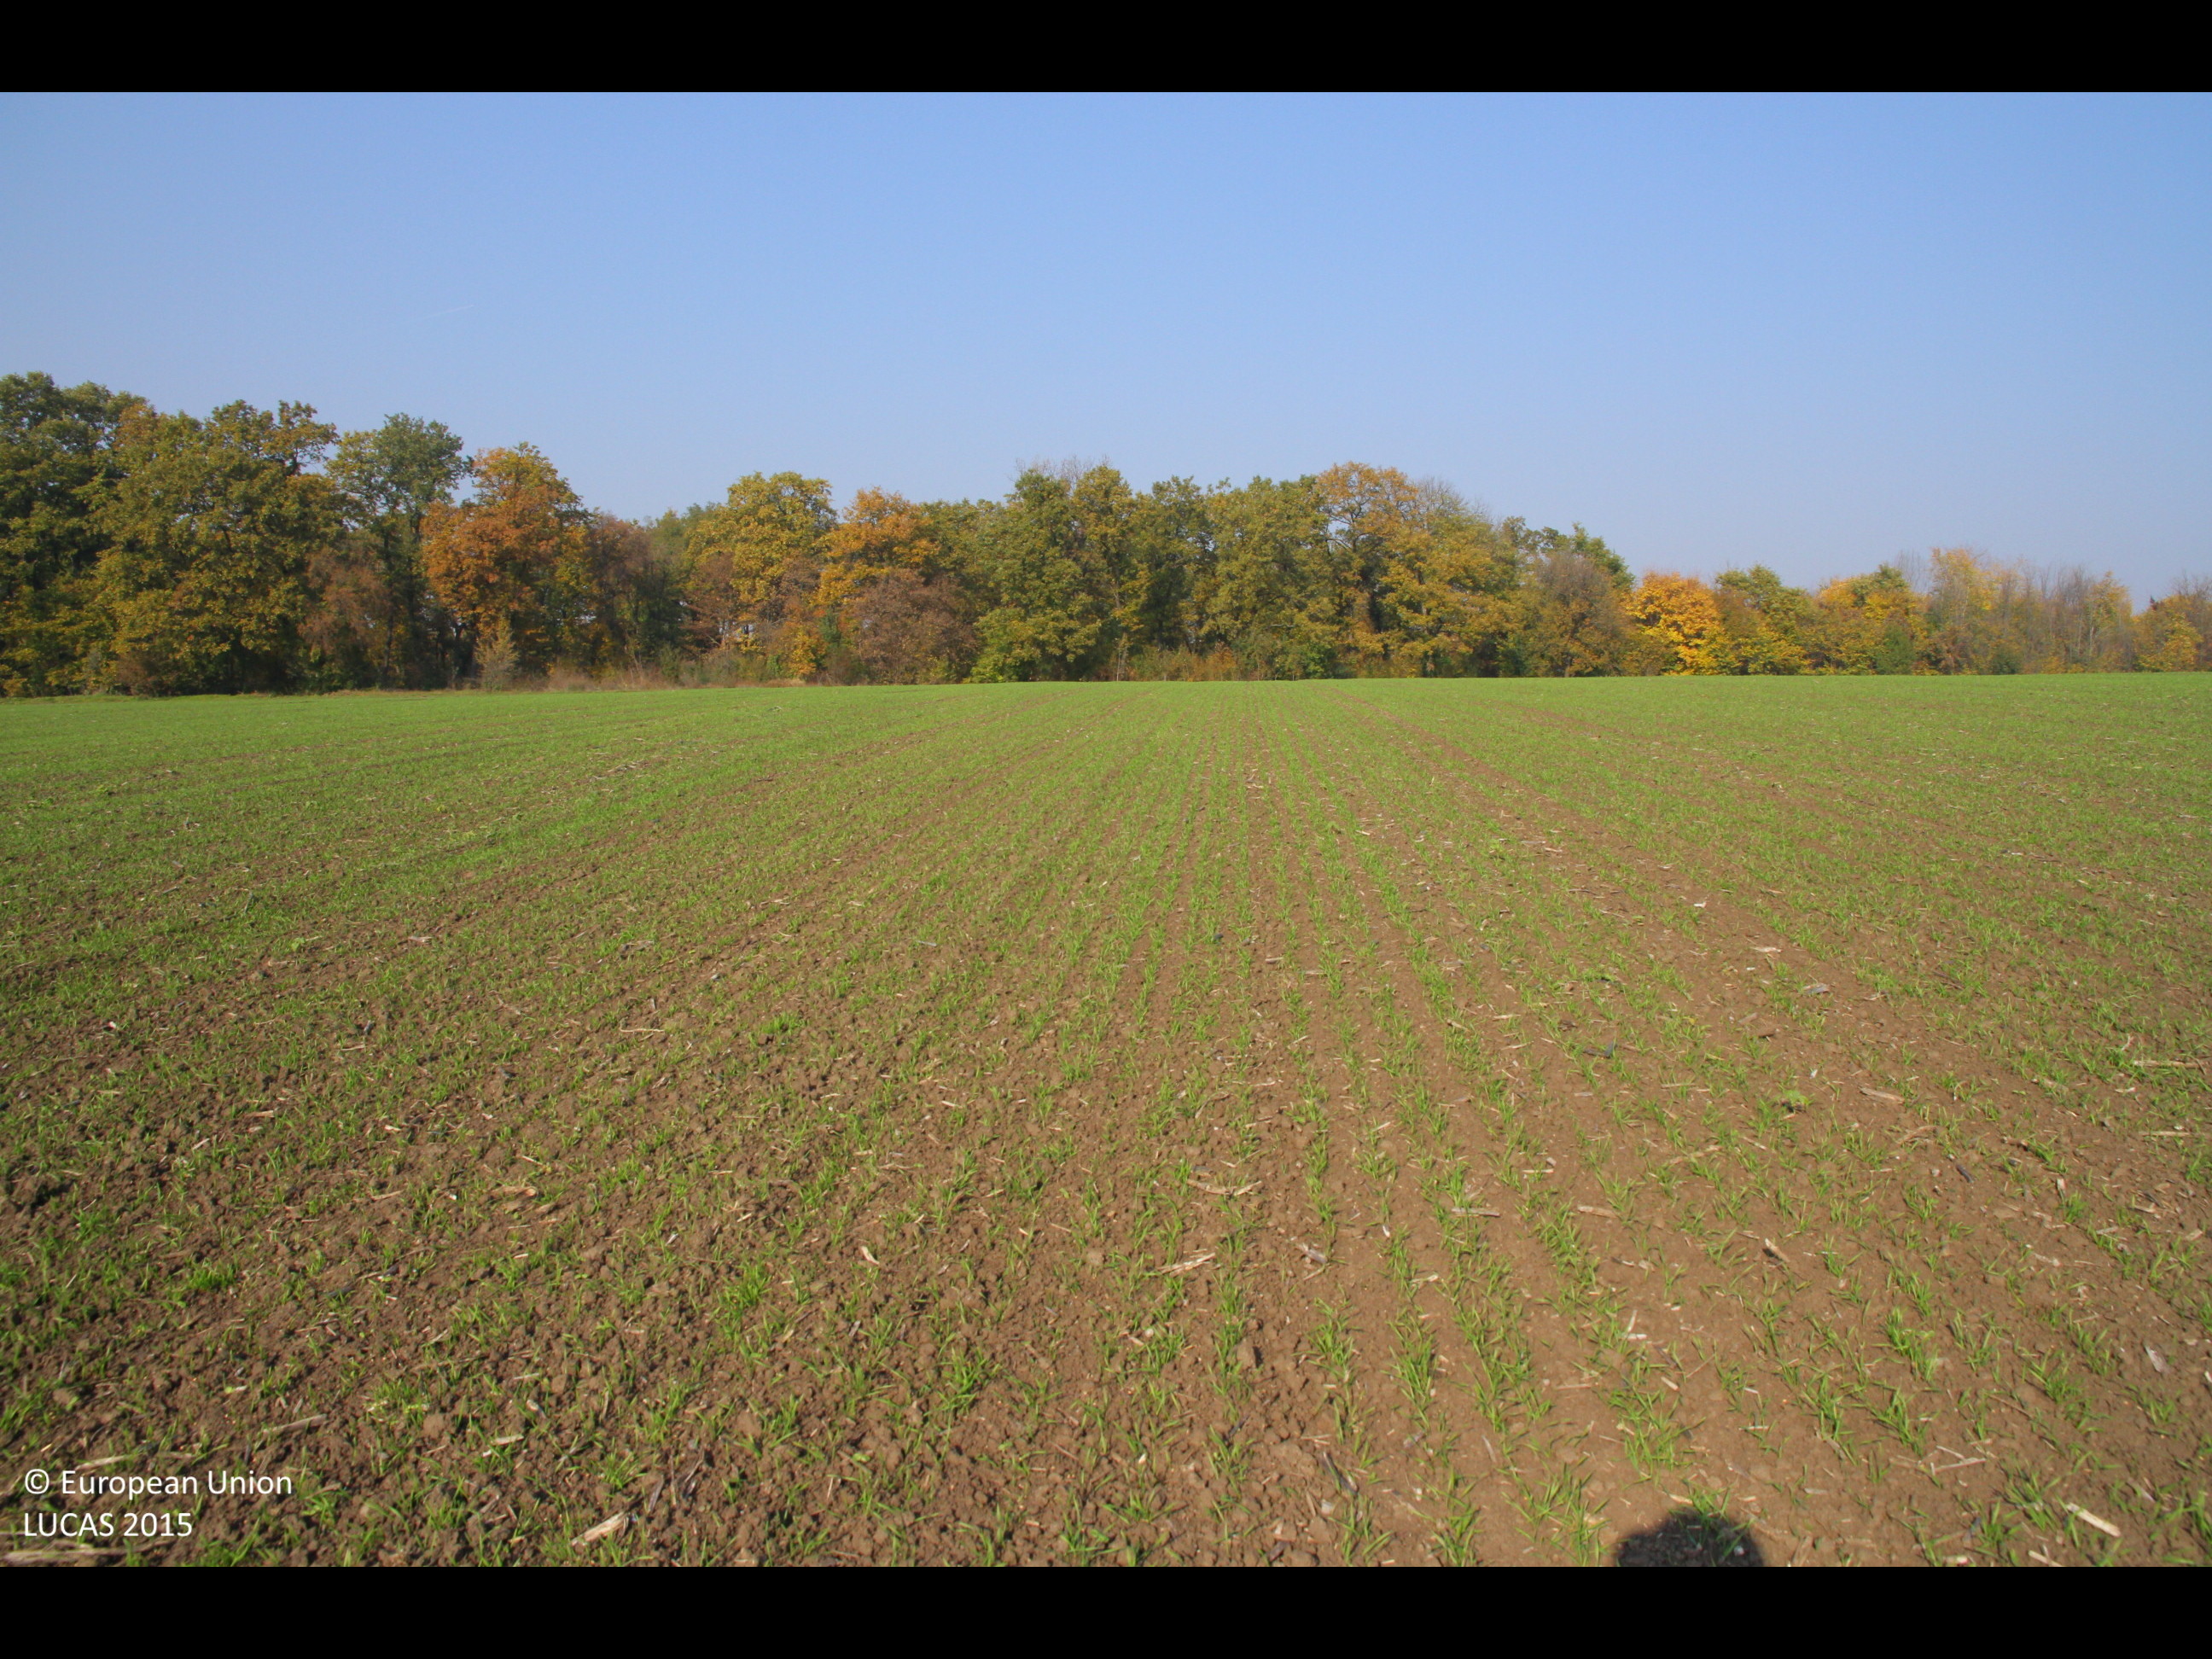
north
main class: Cropland
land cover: Sunflower
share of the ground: < 10 %
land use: Agriculture (excluding fallow land and kitchen gardens)
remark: Harvested field
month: November
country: BG
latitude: 43.7810
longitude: 26.4457
